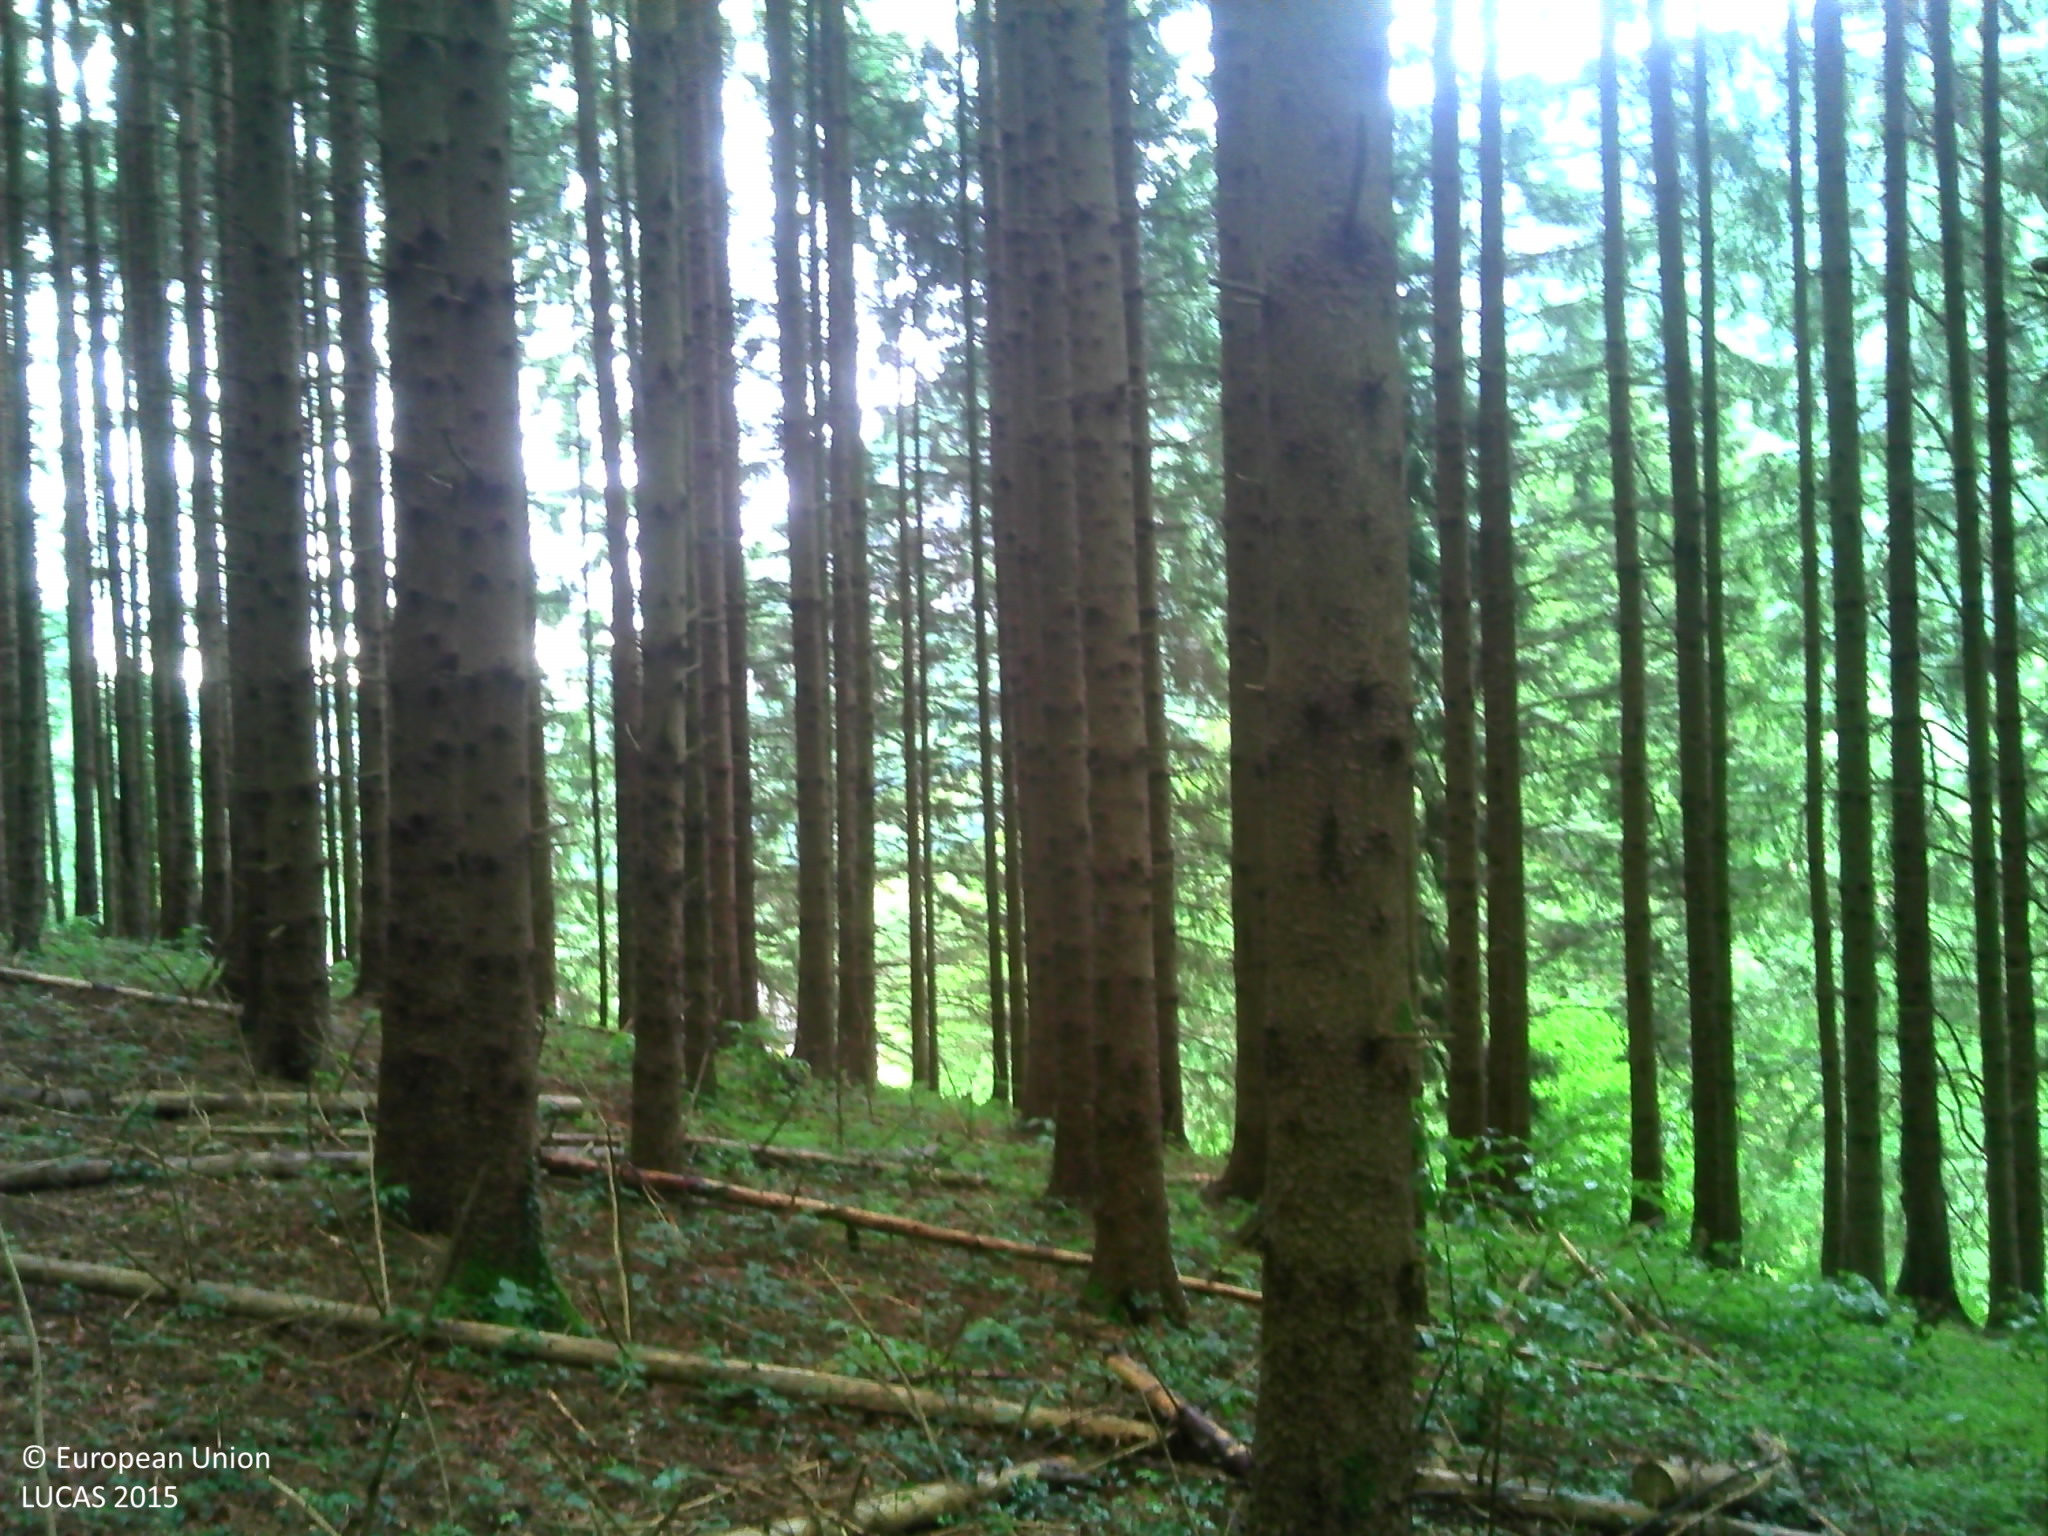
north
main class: Woodland
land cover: Spruce dominated coniferous woodland
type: alpine coniferous forest
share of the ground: > 75 %
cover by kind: coniferous forest trees 70 %, broadleaved forest trees 15 %, herbaceous plants 10 %, lichens and mosses 5 %
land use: Forestry
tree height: > 5 m
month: July
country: FR
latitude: 45.9798
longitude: 6.2735
